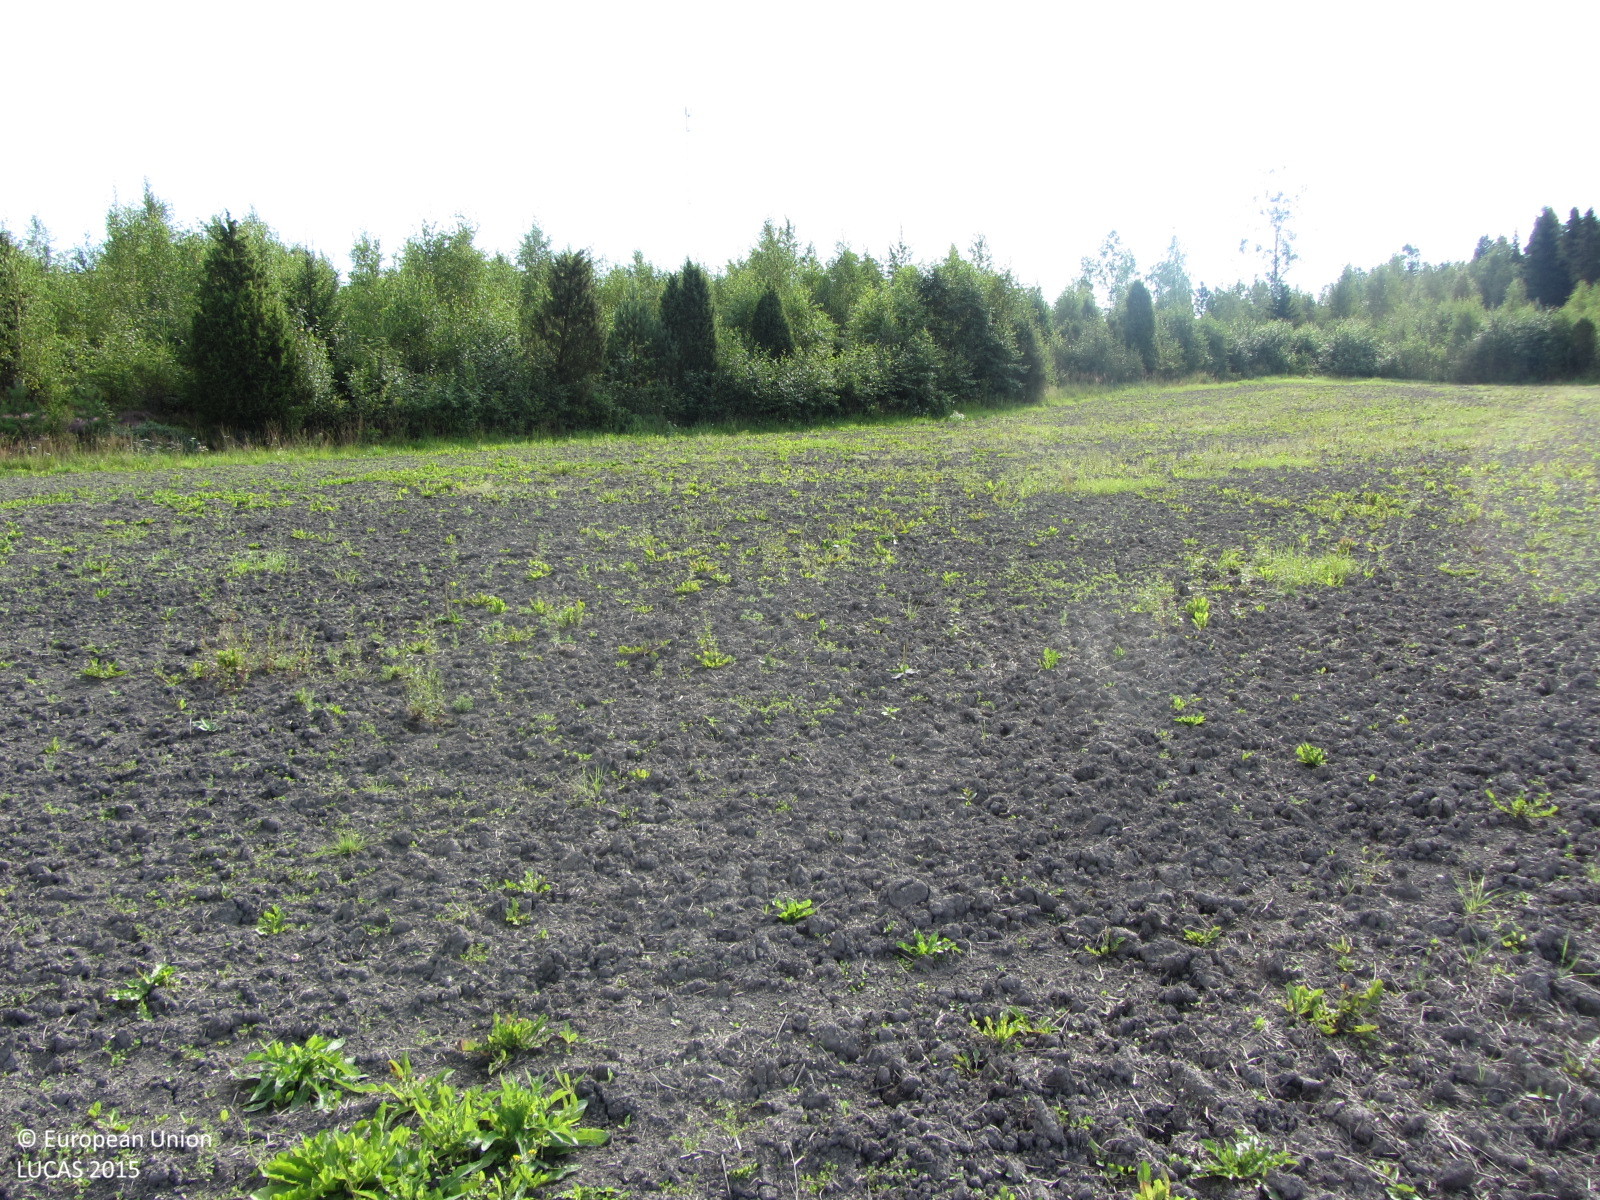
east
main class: Grassland
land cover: Spontaneously vegetated surfaces
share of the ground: 25 - 50 %
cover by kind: unconsolidated bare surface 65 %, herbaceous plants 35 %
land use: Fallow land
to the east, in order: Spontaneously vegetated surfaces; Grass margins; Ditches and canals; Broadleaved woodland; Grassland without tree/shrub cover; Broadleaved woodland; Ditches and canals; Grass margins; Oats; Ditches and canals; Pine dominated mixed woodland
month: August
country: FI
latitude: 60.4129
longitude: 23.4313
